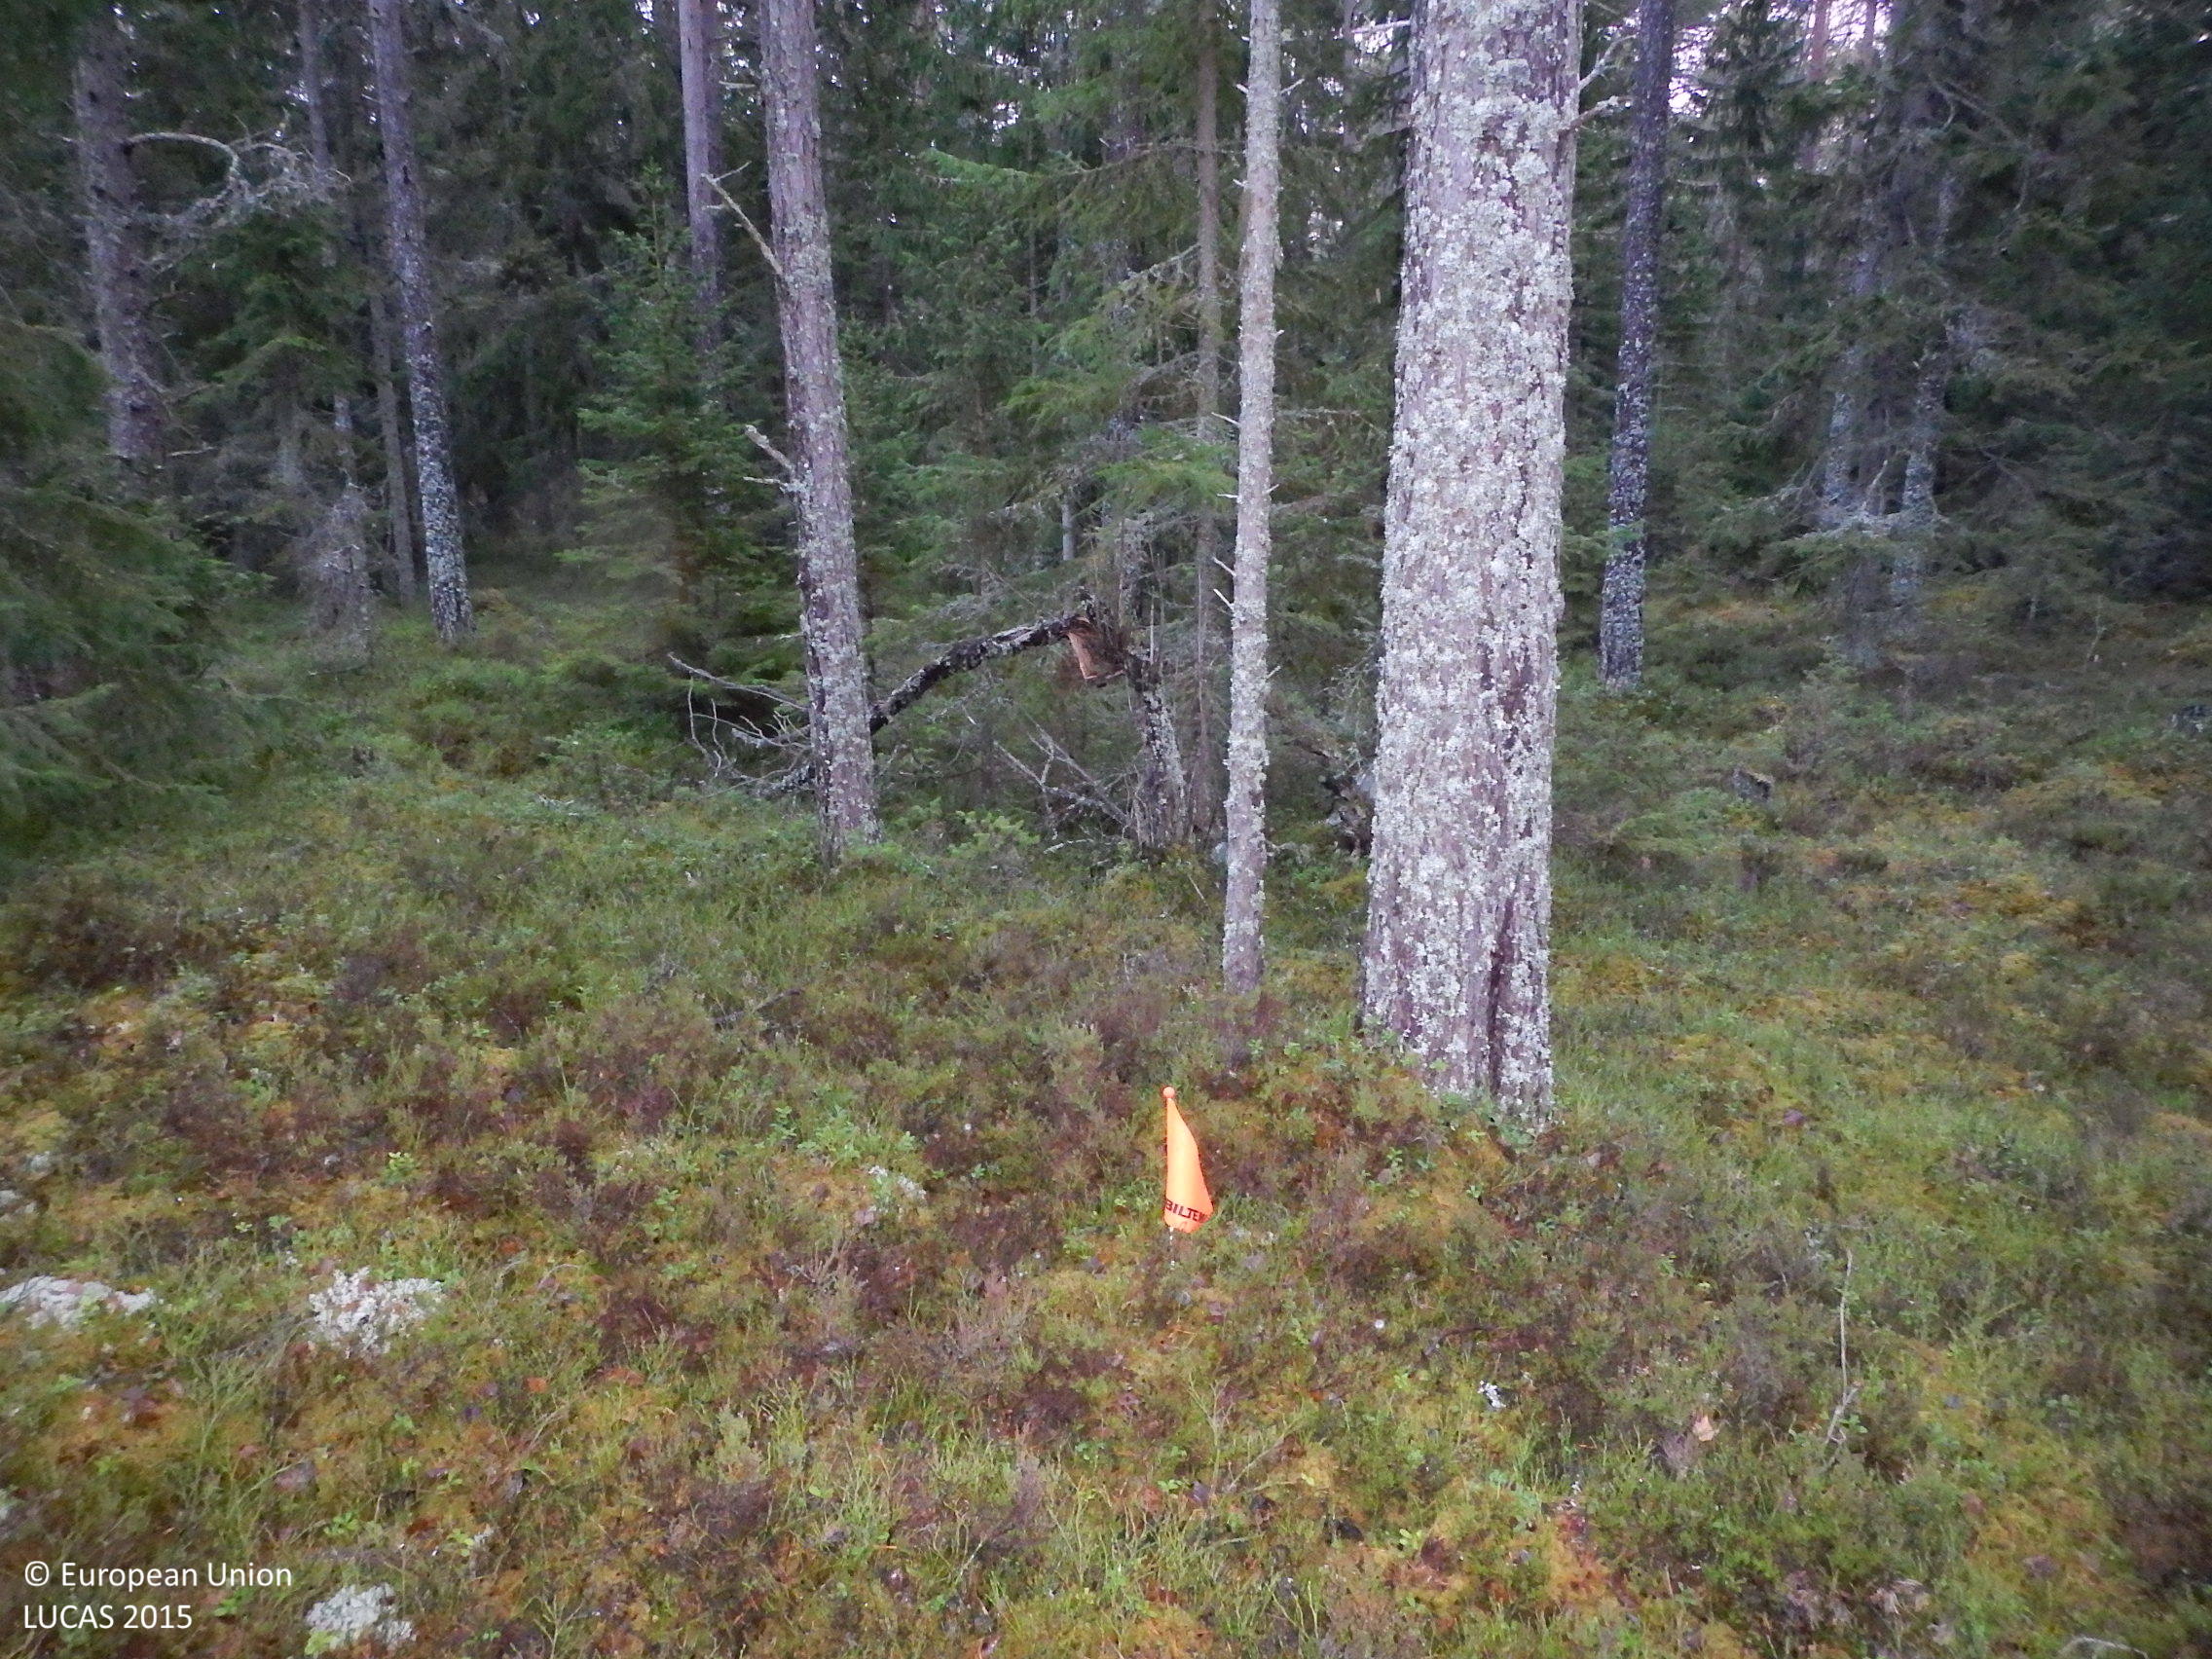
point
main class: Woodland
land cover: Pine dominated coniferous woodland
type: boreal forest
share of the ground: 50 - 75 %
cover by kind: coniferous forest trees 70 %, shrubs 20 %, lichens and mosses 10 %
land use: Semi-natural and natural areas not in use
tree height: > 5 m
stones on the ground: < 10 %
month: November
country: SE
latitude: 61.6295
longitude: 17.4746
